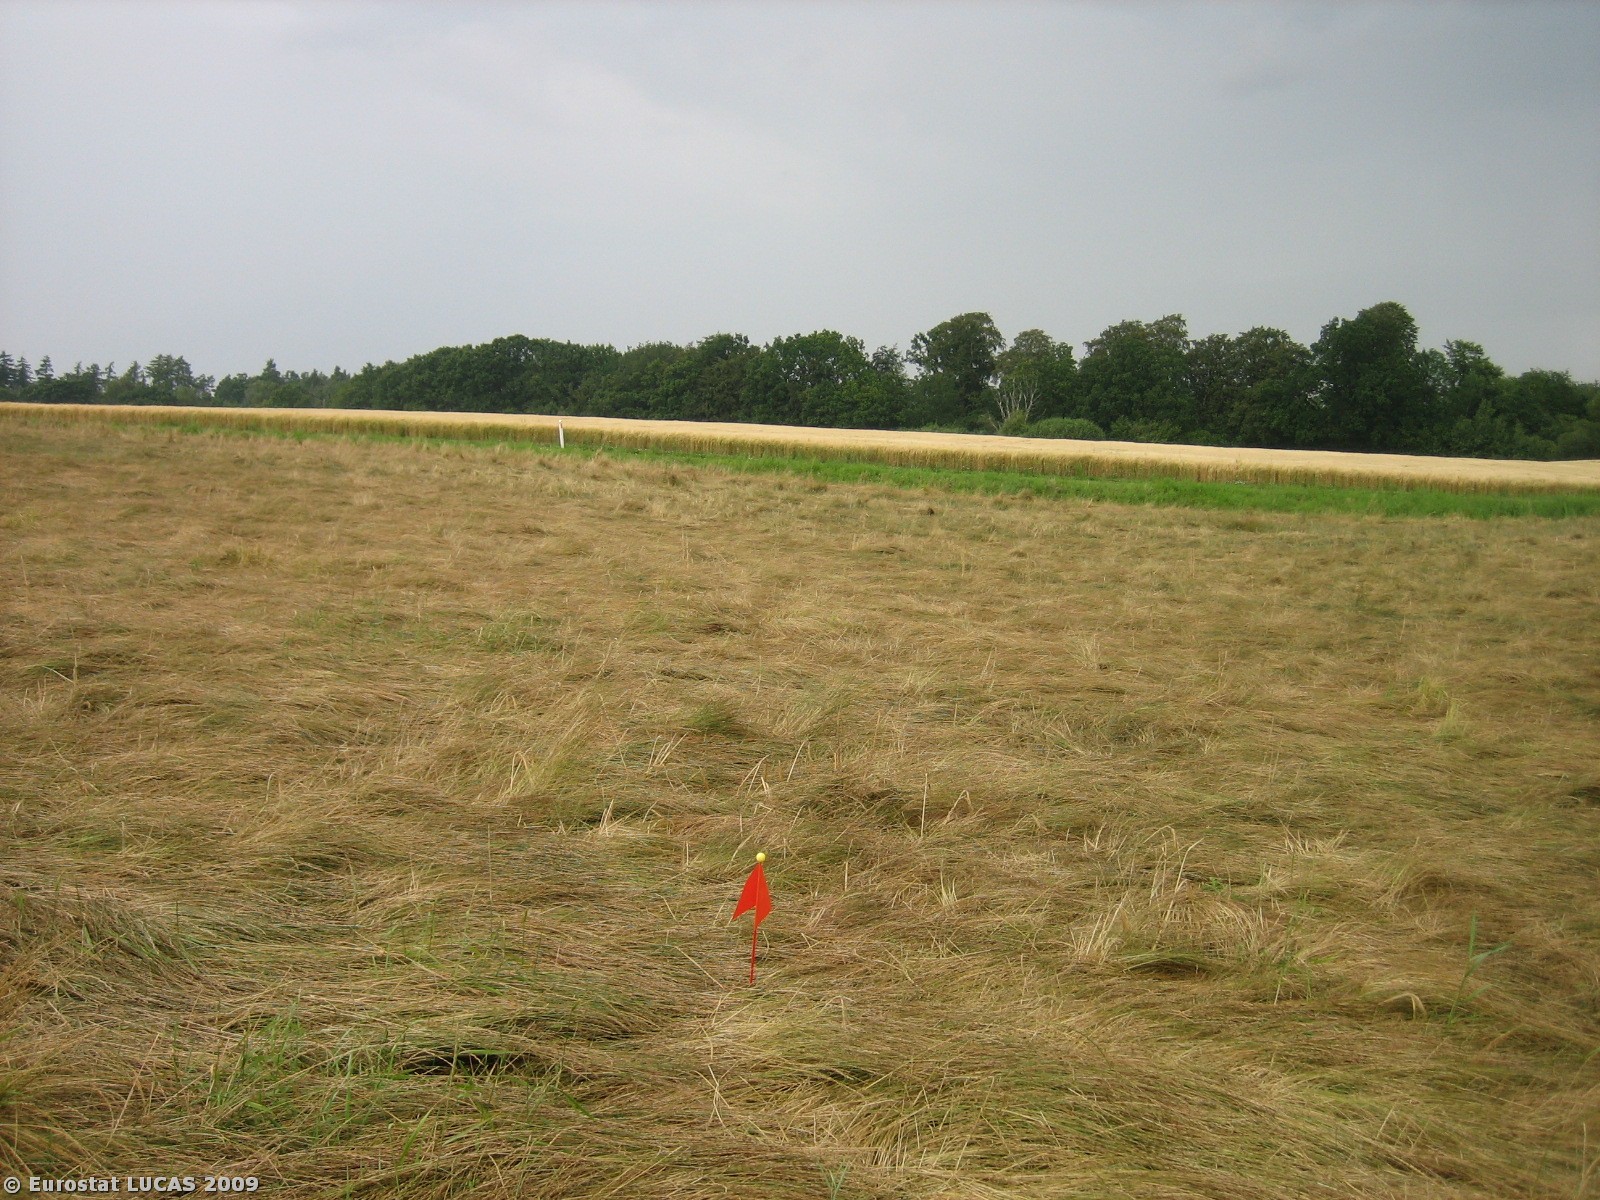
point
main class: Cropland
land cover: Temporary grasslands
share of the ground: > 75 %
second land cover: Barley
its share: < 10 %
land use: Agriculture (excluding fallow land and kitchen gardens)
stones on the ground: < 10 %
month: July
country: DK
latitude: 55.3789
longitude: 9.9842
